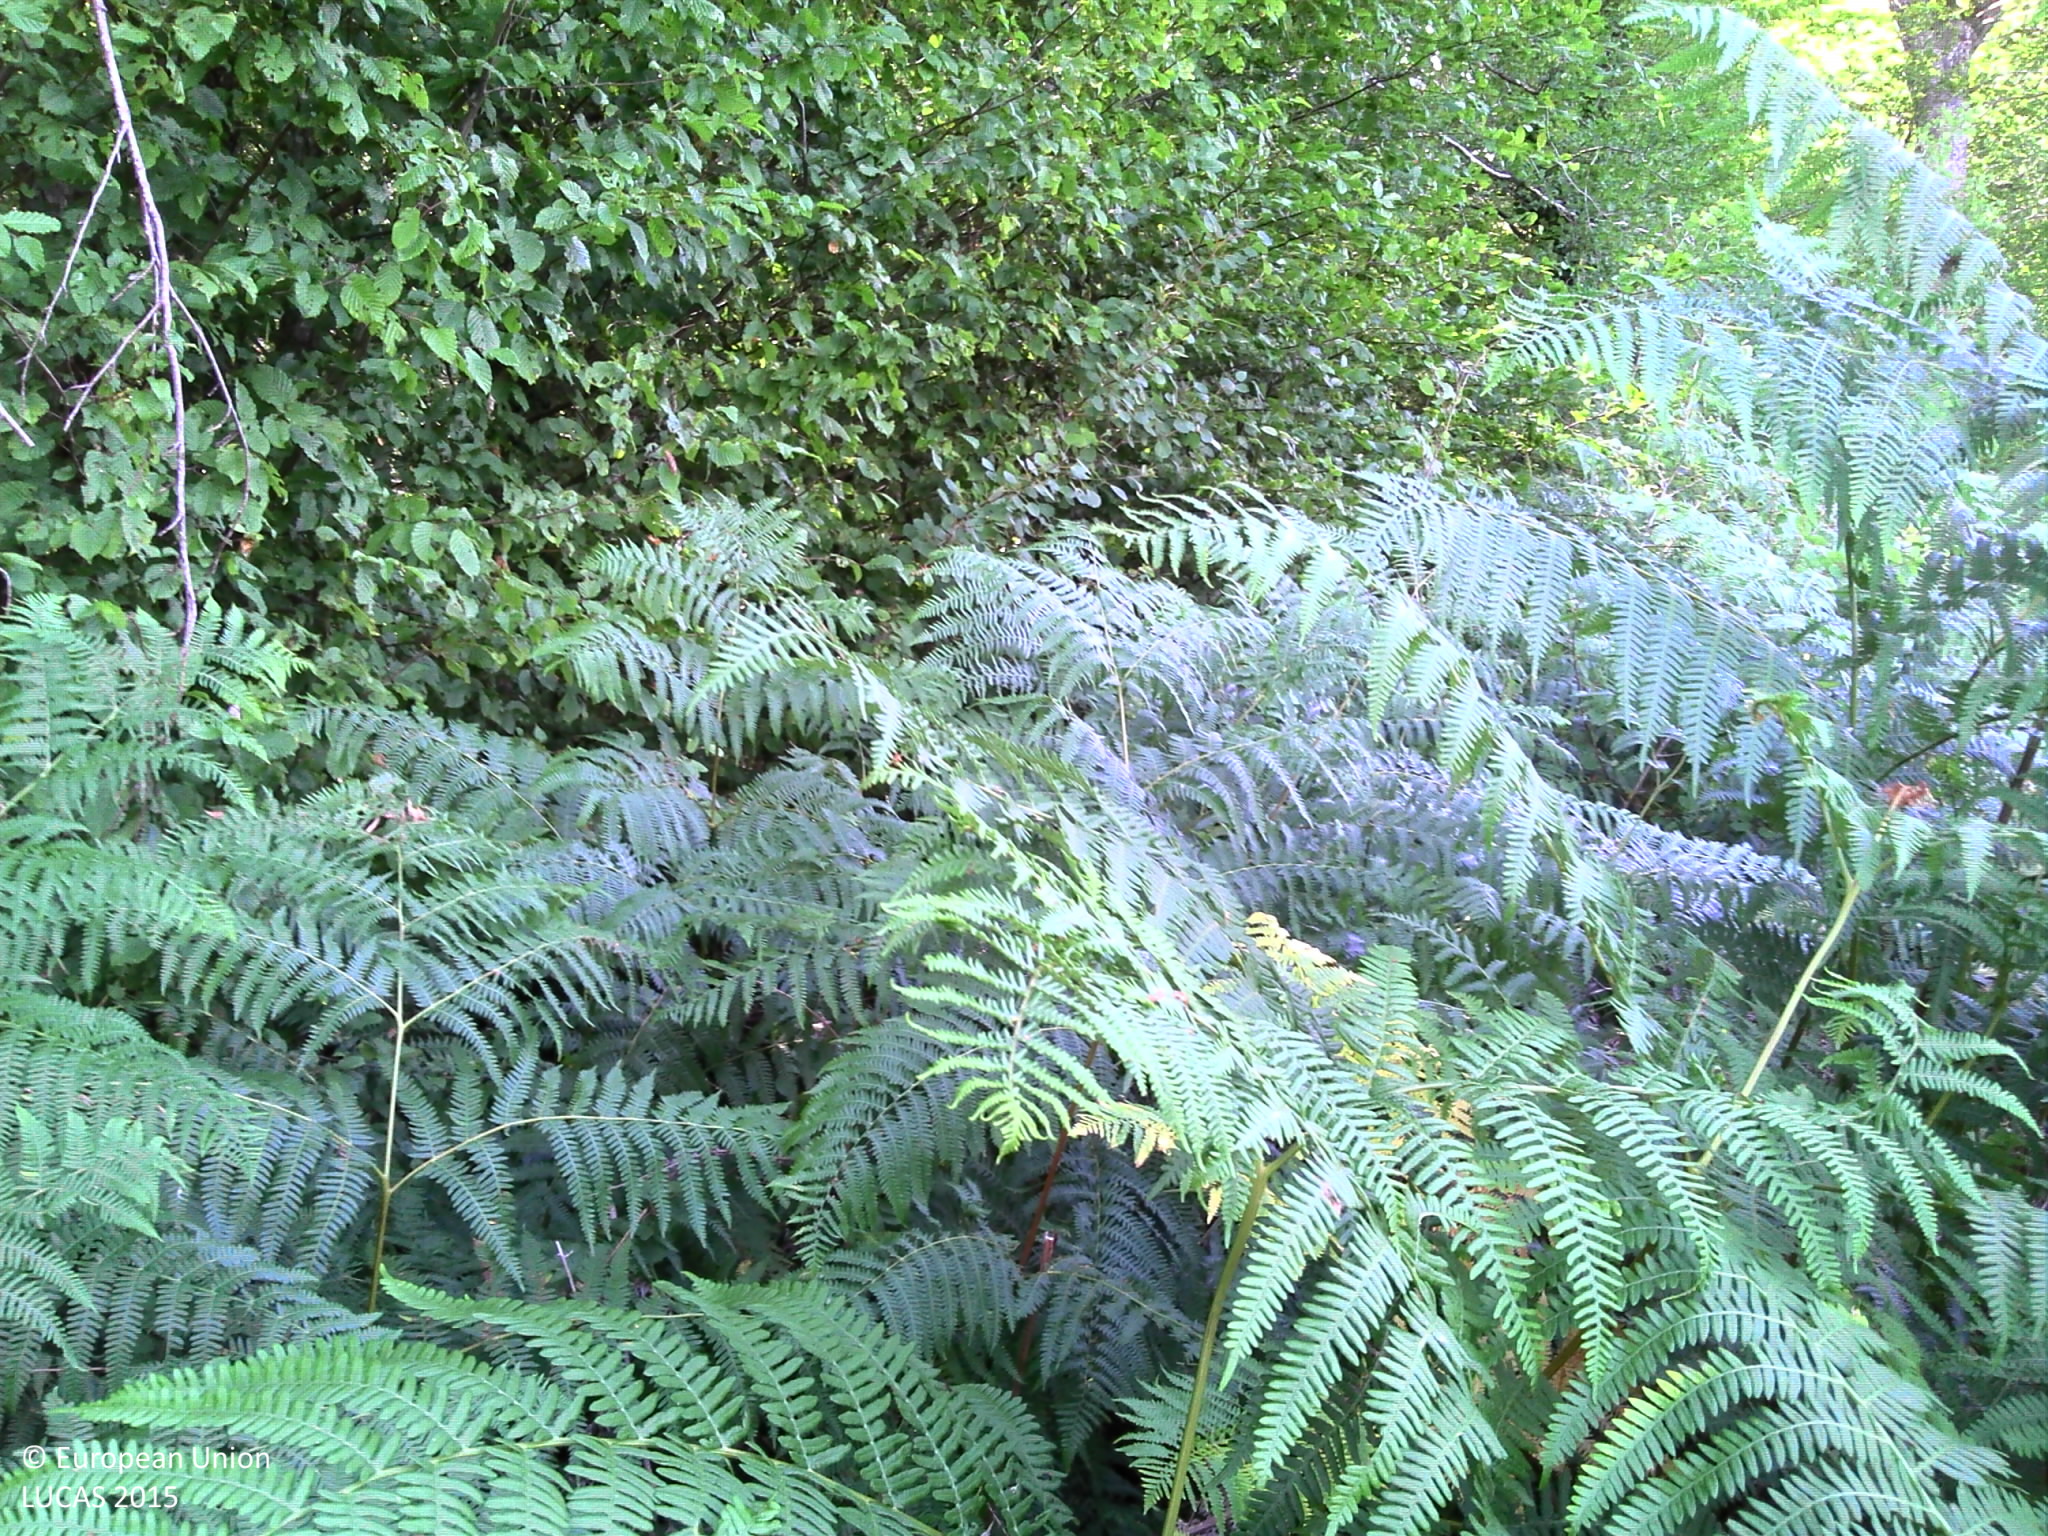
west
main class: Shrubland
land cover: Shrubland with sparse tree cover
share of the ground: > 75 %
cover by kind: herbaceous plants 80 %, shrubs 15 %, broadleaved forest trees 5 %
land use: Semi-natural and natural areas not in use
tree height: < 5 m
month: July
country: FR
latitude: 48.0279
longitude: 3.4373
